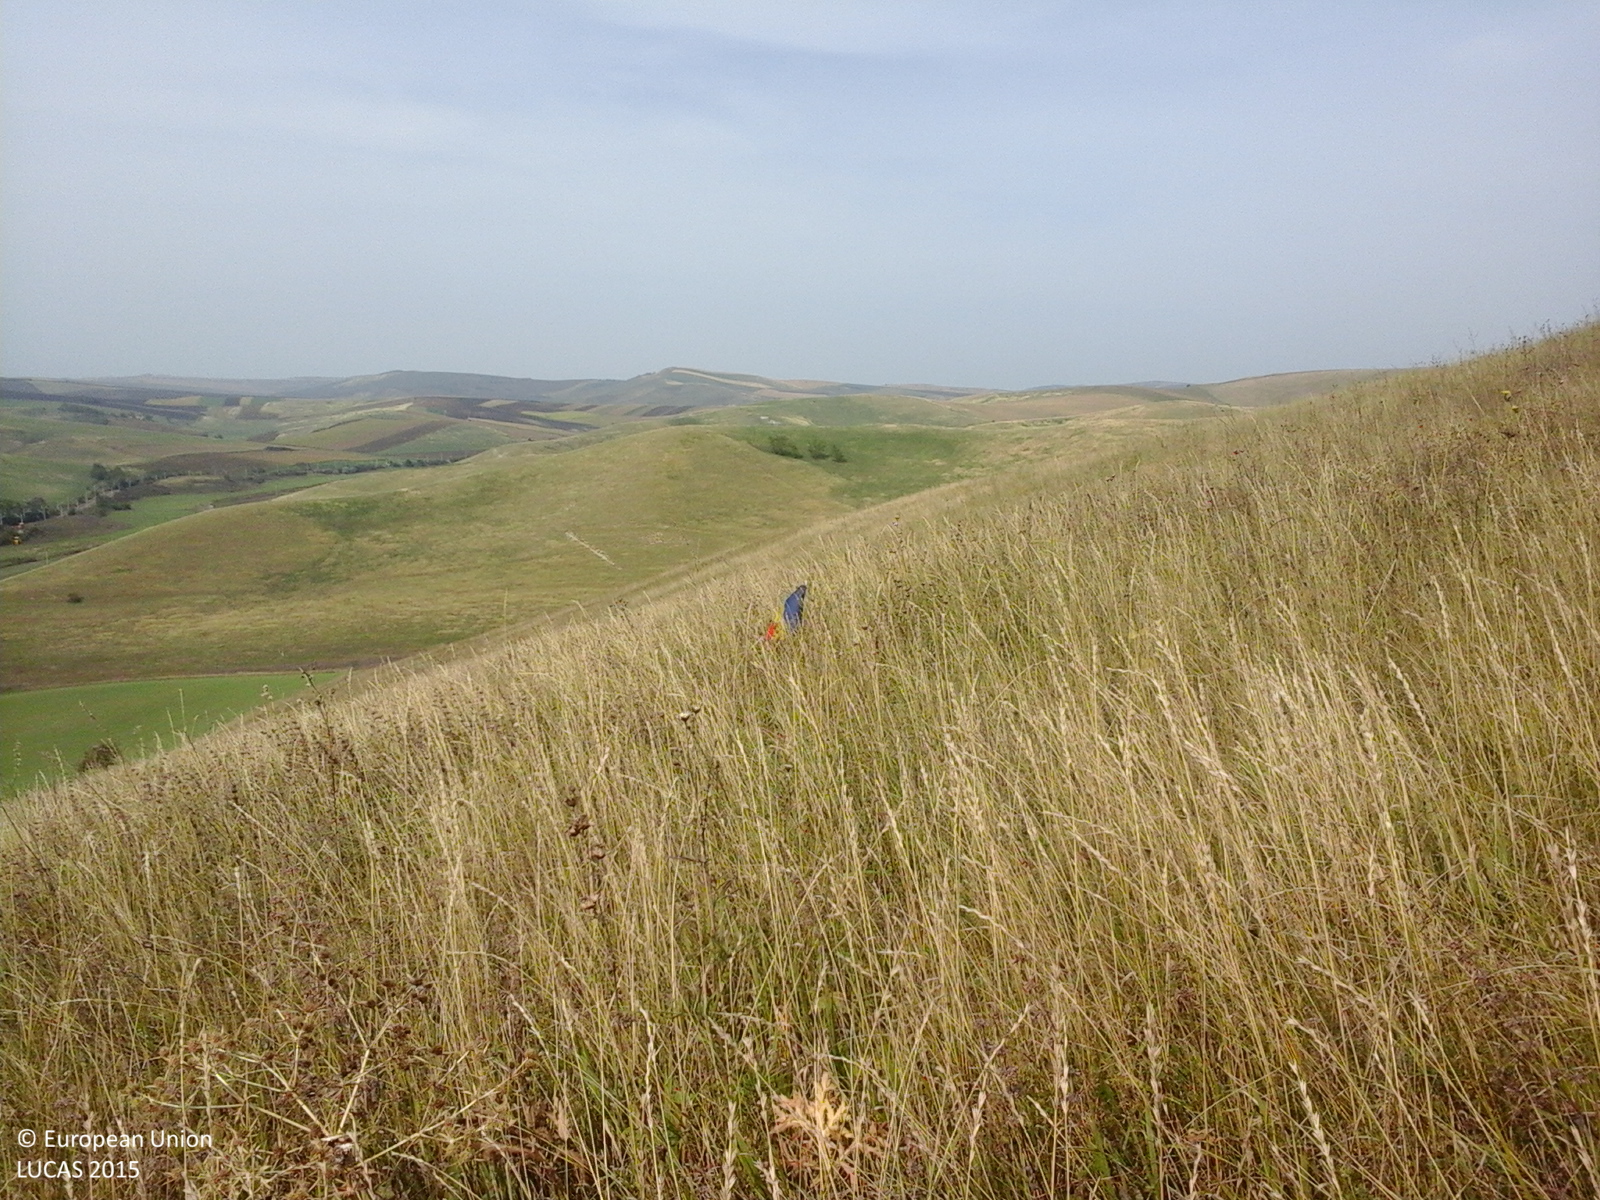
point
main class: Grassland
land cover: Grassland without tree/shrub cover
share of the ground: > 75 %
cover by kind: herbaceous plants 100 %
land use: Agriculture (excluding fallow land and kitchen gardens)
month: September
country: RO
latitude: 46.6137
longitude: 23.8504
